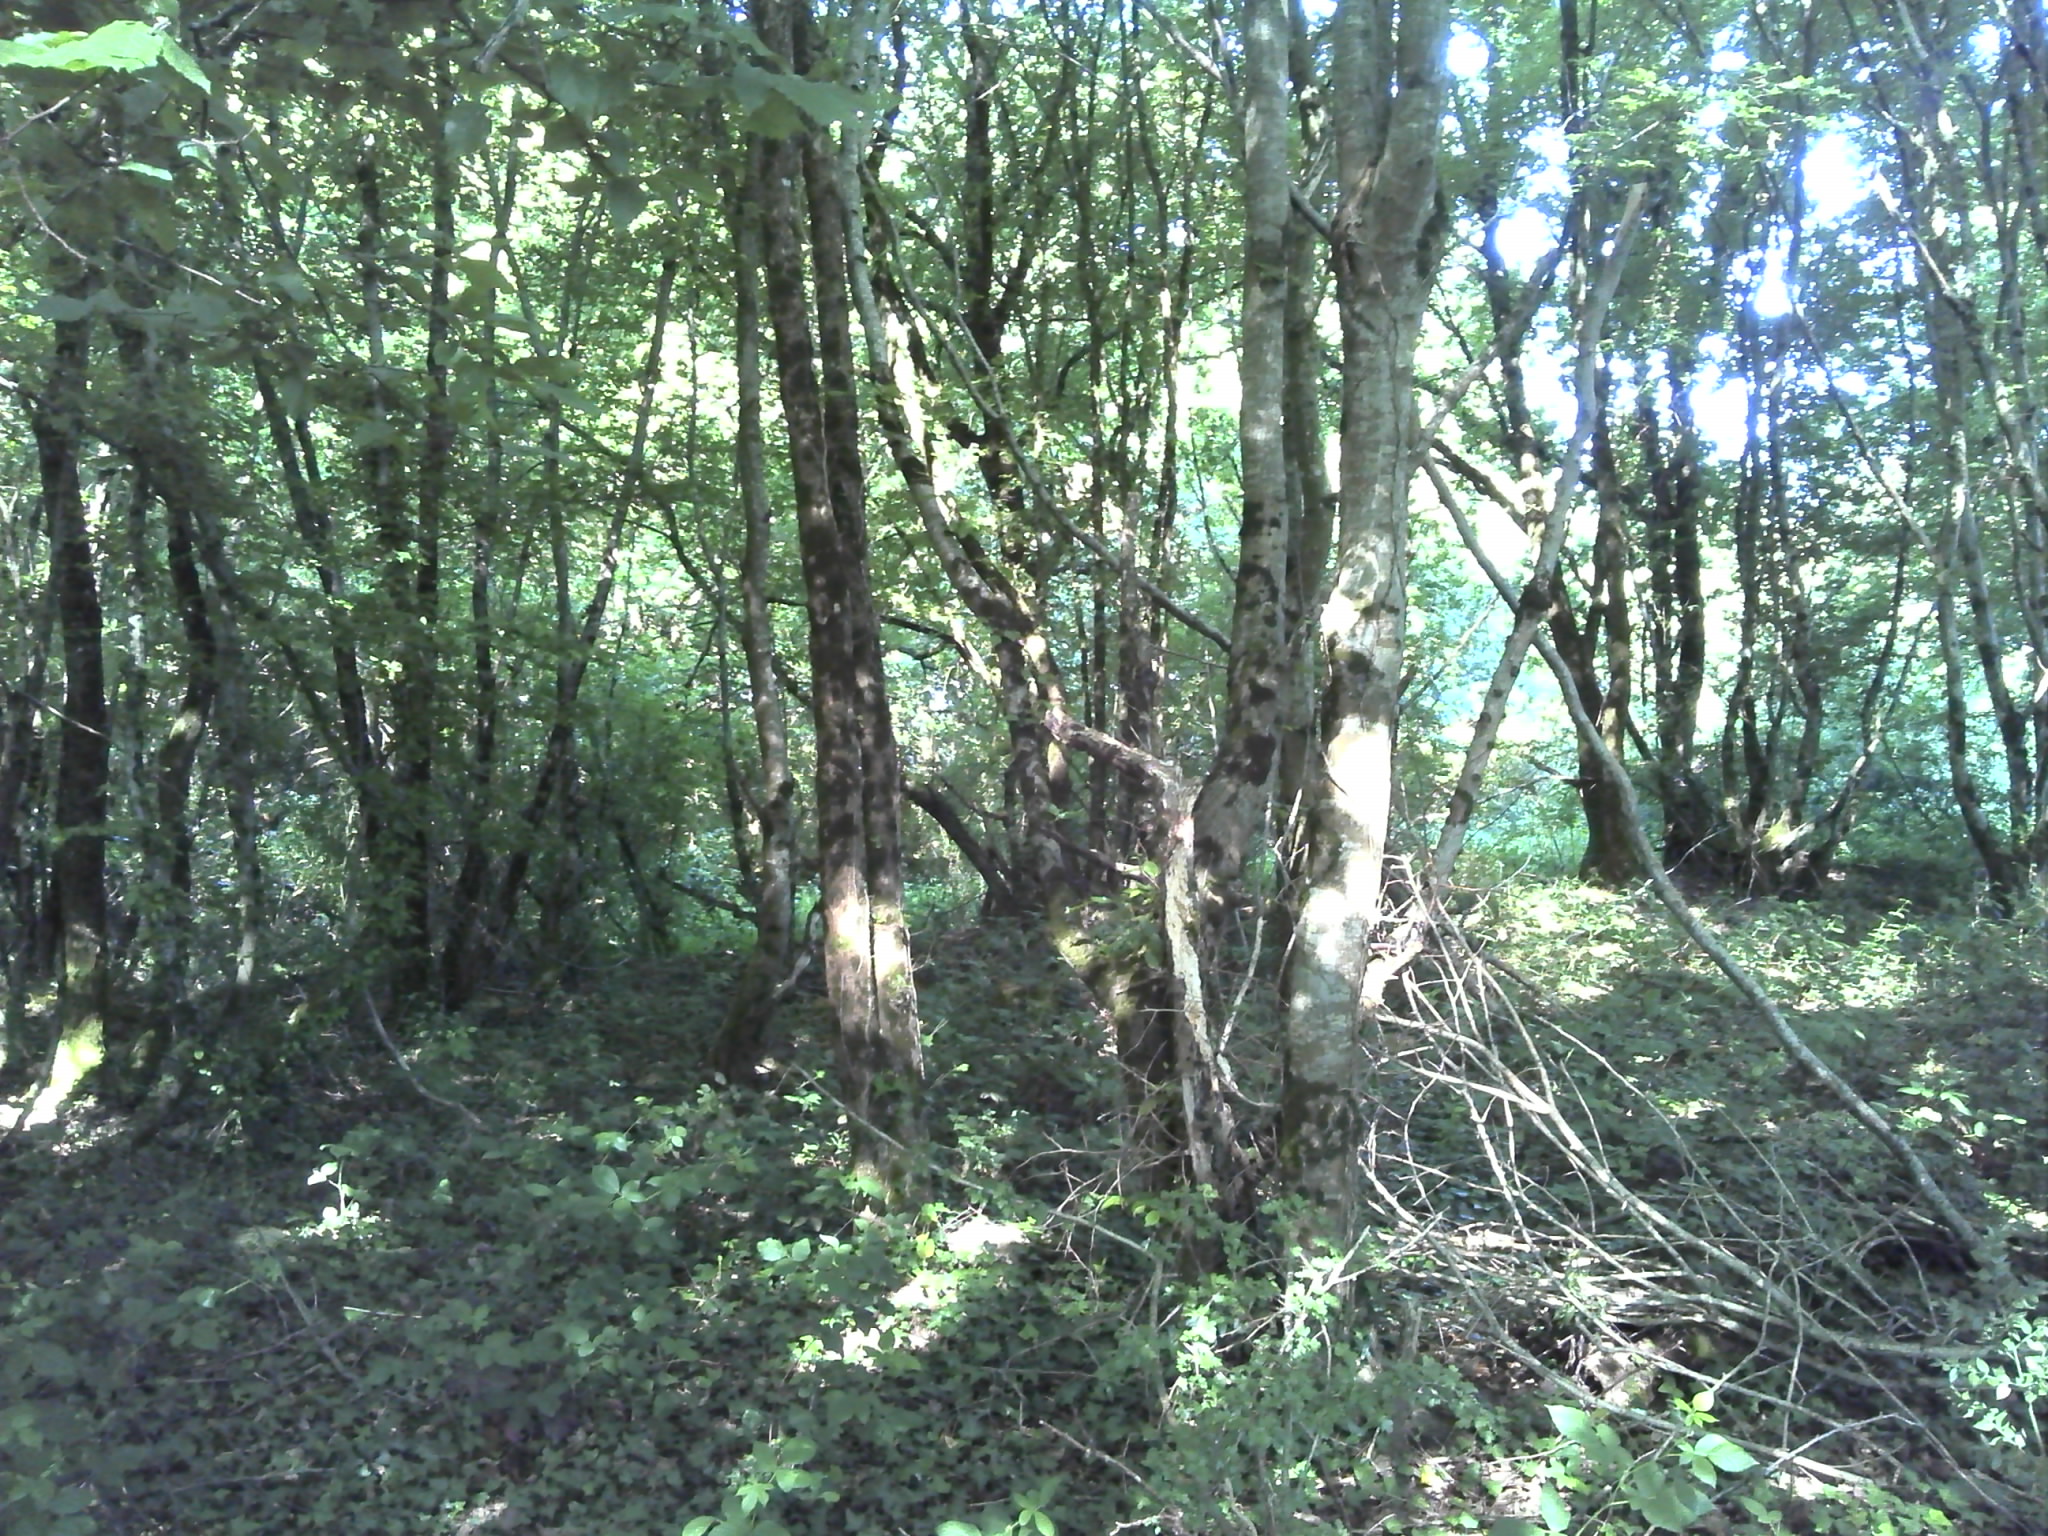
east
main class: Woodland
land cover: Broadleaved woodland
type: mesophytic deciduous forest
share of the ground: > 75 %
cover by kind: broadleaved forest trees 90 %, herbaceous plants 10 %
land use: Forestry
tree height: > 5 m
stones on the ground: < 10 %
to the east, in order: Broadleaved woodland; Ditches and canals; Grass margins; Shrubland without tree cover; Tracks; Broadleaved woodland; Fences; Barley; Abandoned hedges; Single bushes/trees; Ditches and canals; Grass margins; Paved roads, cycling and walking lanes; Electric lines; Grass margins; Ditches and canals; Managed hedges; Fences; Grassland without tree/shrub cover
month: June
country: FR
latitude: 46.6054
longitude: 1.6740
